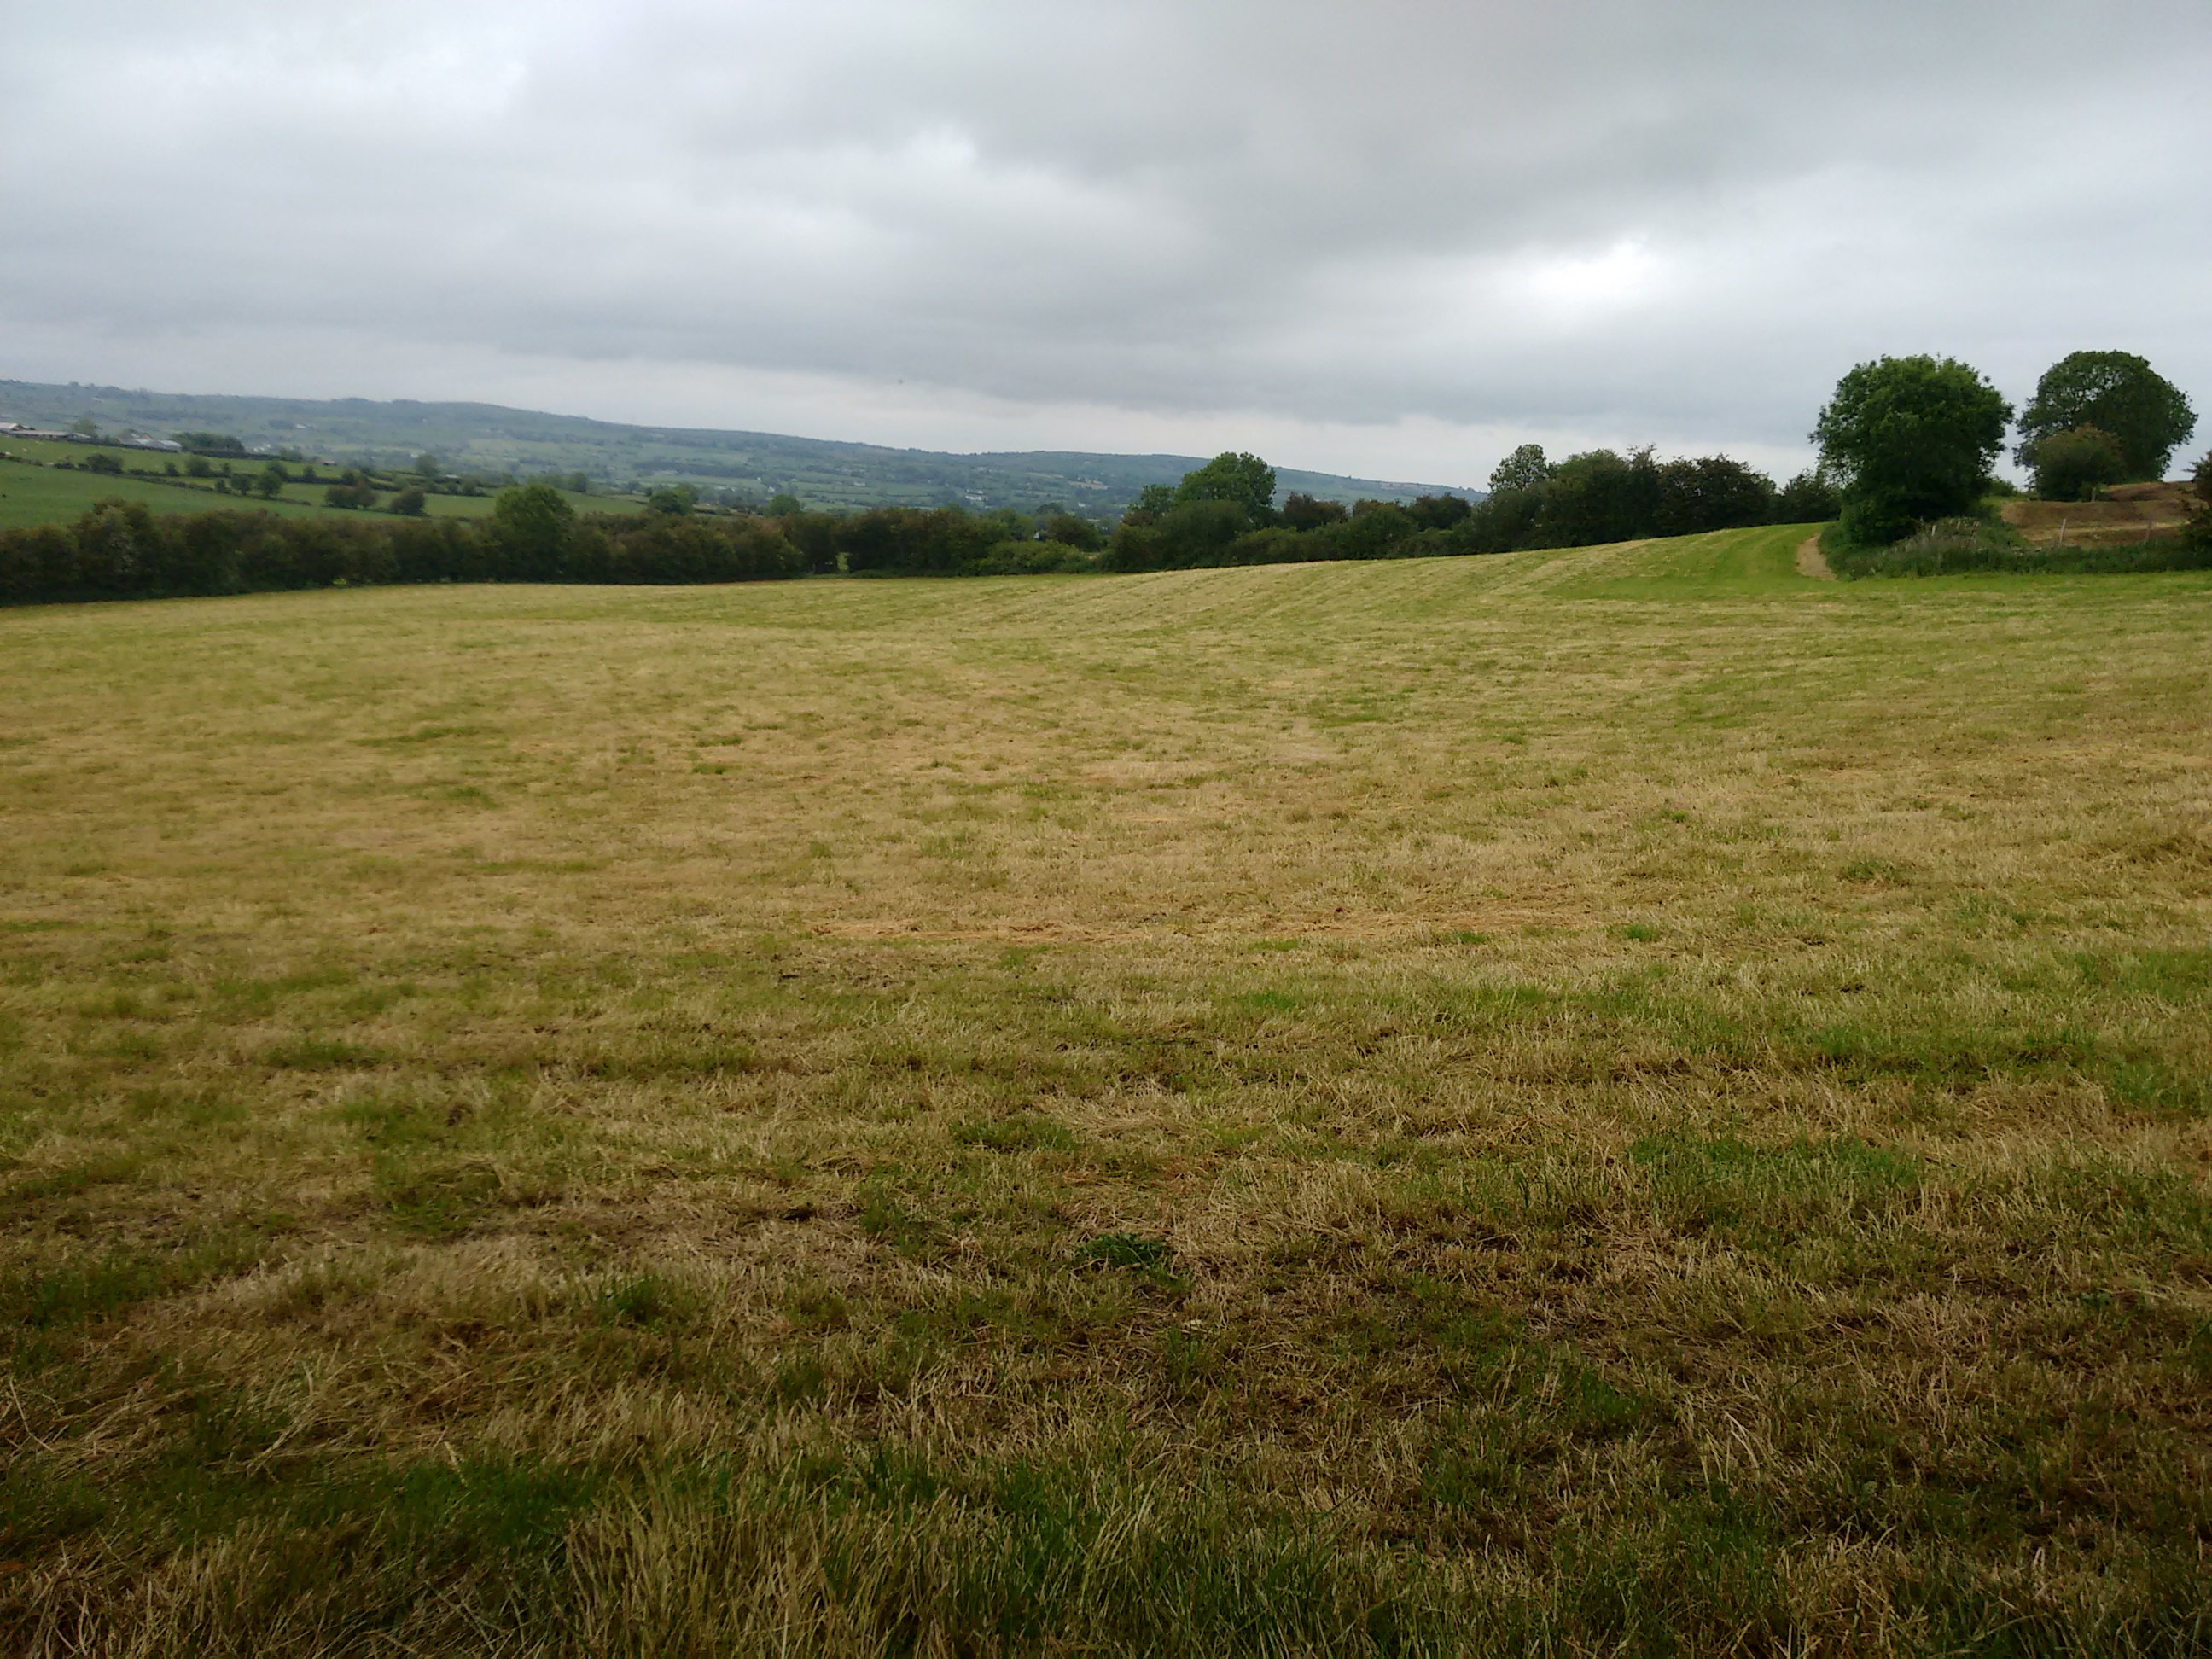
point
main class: Grassland
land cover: Grassland without tree/shrub cover
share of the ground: > 75 %
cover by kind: herbaceous plants 100 %
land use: Agriculture (excluding fallow land and kitchen gardens)
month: June
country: GB
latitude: 54.6913
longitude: -7.5159
